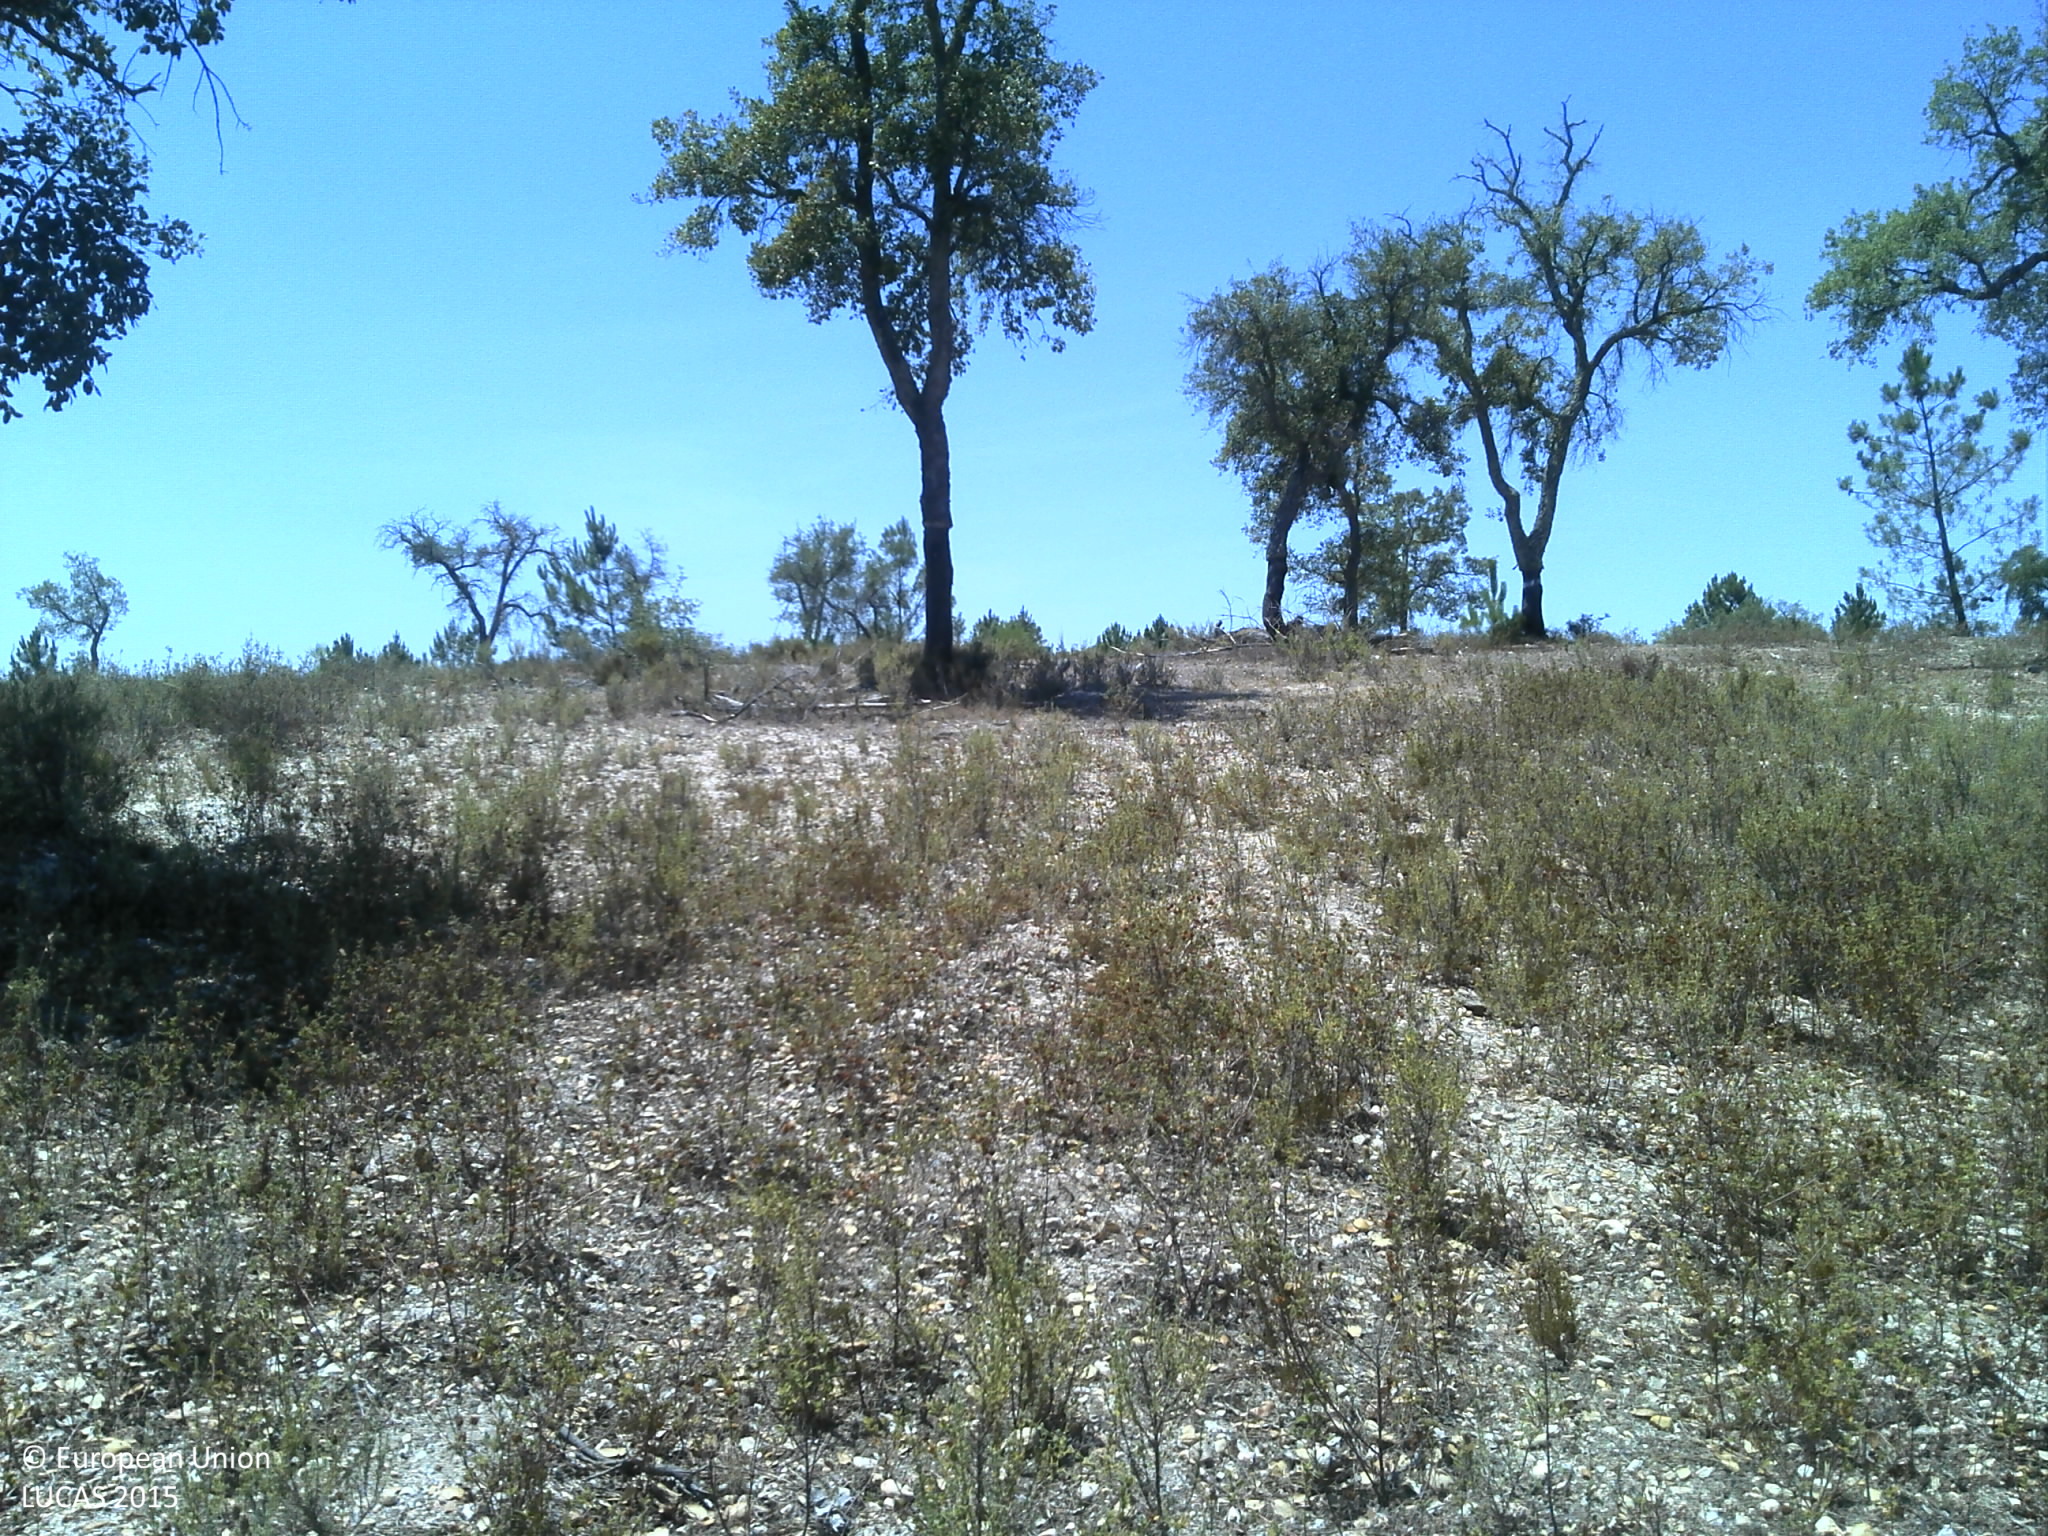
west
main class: Grassland
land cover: Grassland with sparse tree/shrub cover
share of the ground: 25 - 50 %
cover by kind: unconsolidated bare surface 70 %, herbaceous plants 25 %, broadleaved forest trees 5 %
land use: Agriculture (excluding fallow land and kitchen gardens)
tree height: < 5 m
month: July
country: PT
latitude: 39.1604
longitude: -8.1925
